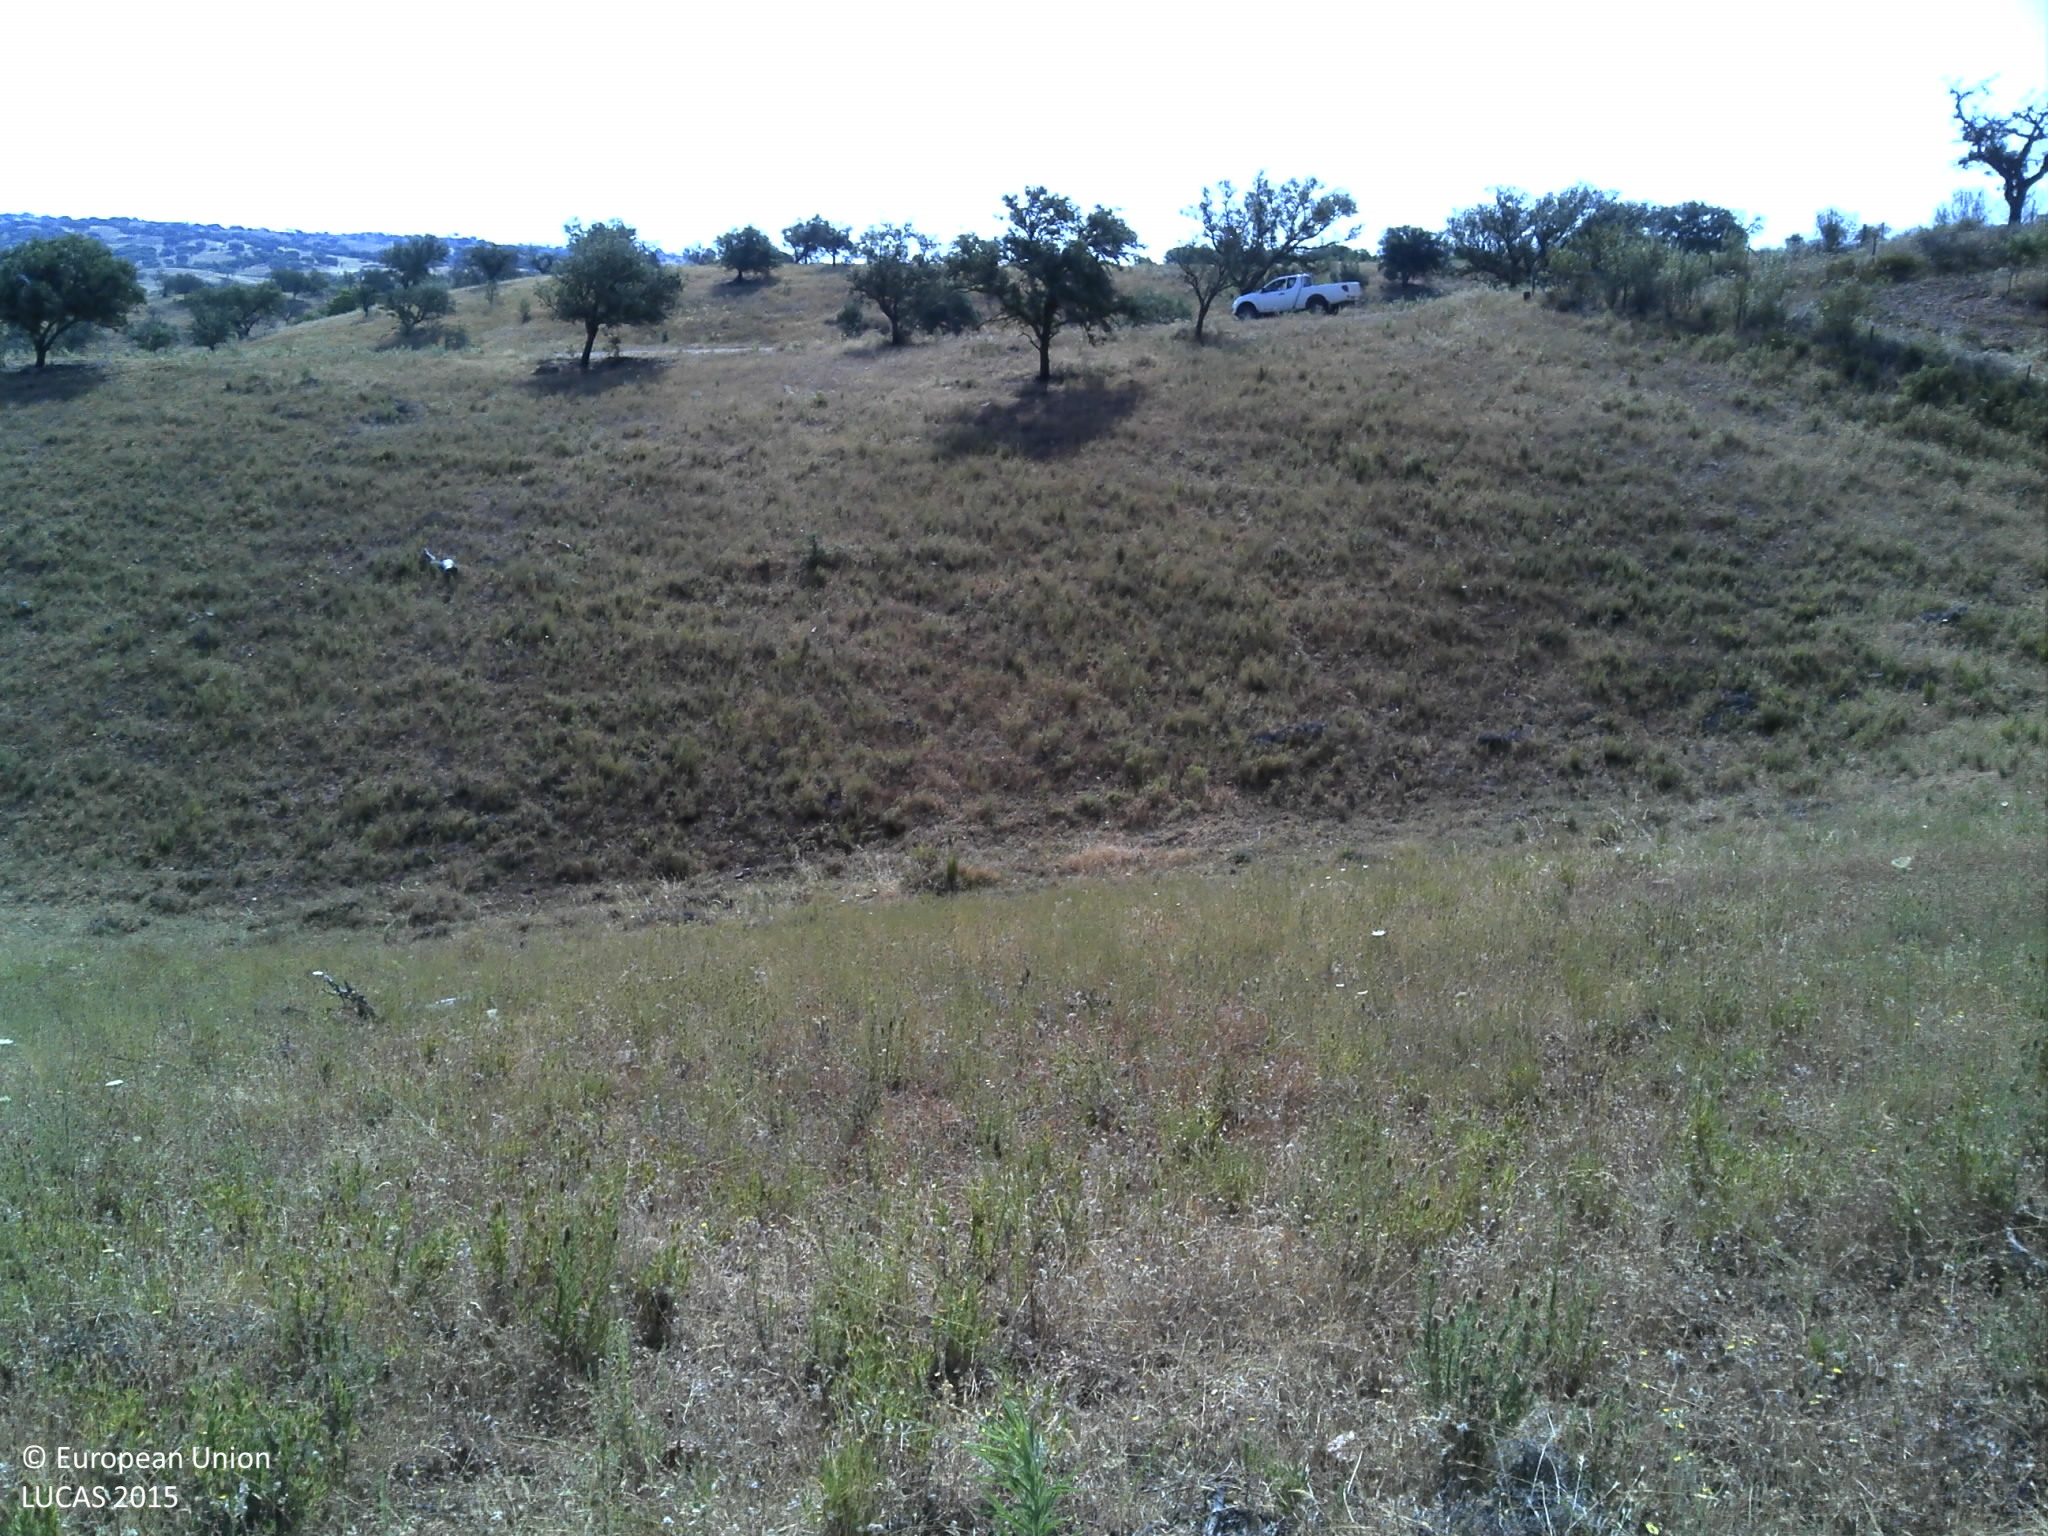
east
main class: Grassland
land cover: Grassland with sparse tree/shrub cover
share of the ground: 50 - 75 %
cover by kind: herbaceous plants 95 %, broadleaved forest trees 5 %
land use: Agriculture (excluding fallow land and kitchen gardens)
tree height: < 5 m
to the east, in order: Grassland with sparse tree/shrub cover; Grassland without tree/shrub cover; Fences; Grass margins; Tracks; Grassland without tree/shrub cover; Broadleaved woodland; Other structural elements; Broadleaved woodland; Grassland without tree/shrub cover
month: June
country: PT
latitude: 37.7776
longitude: -7.4879
